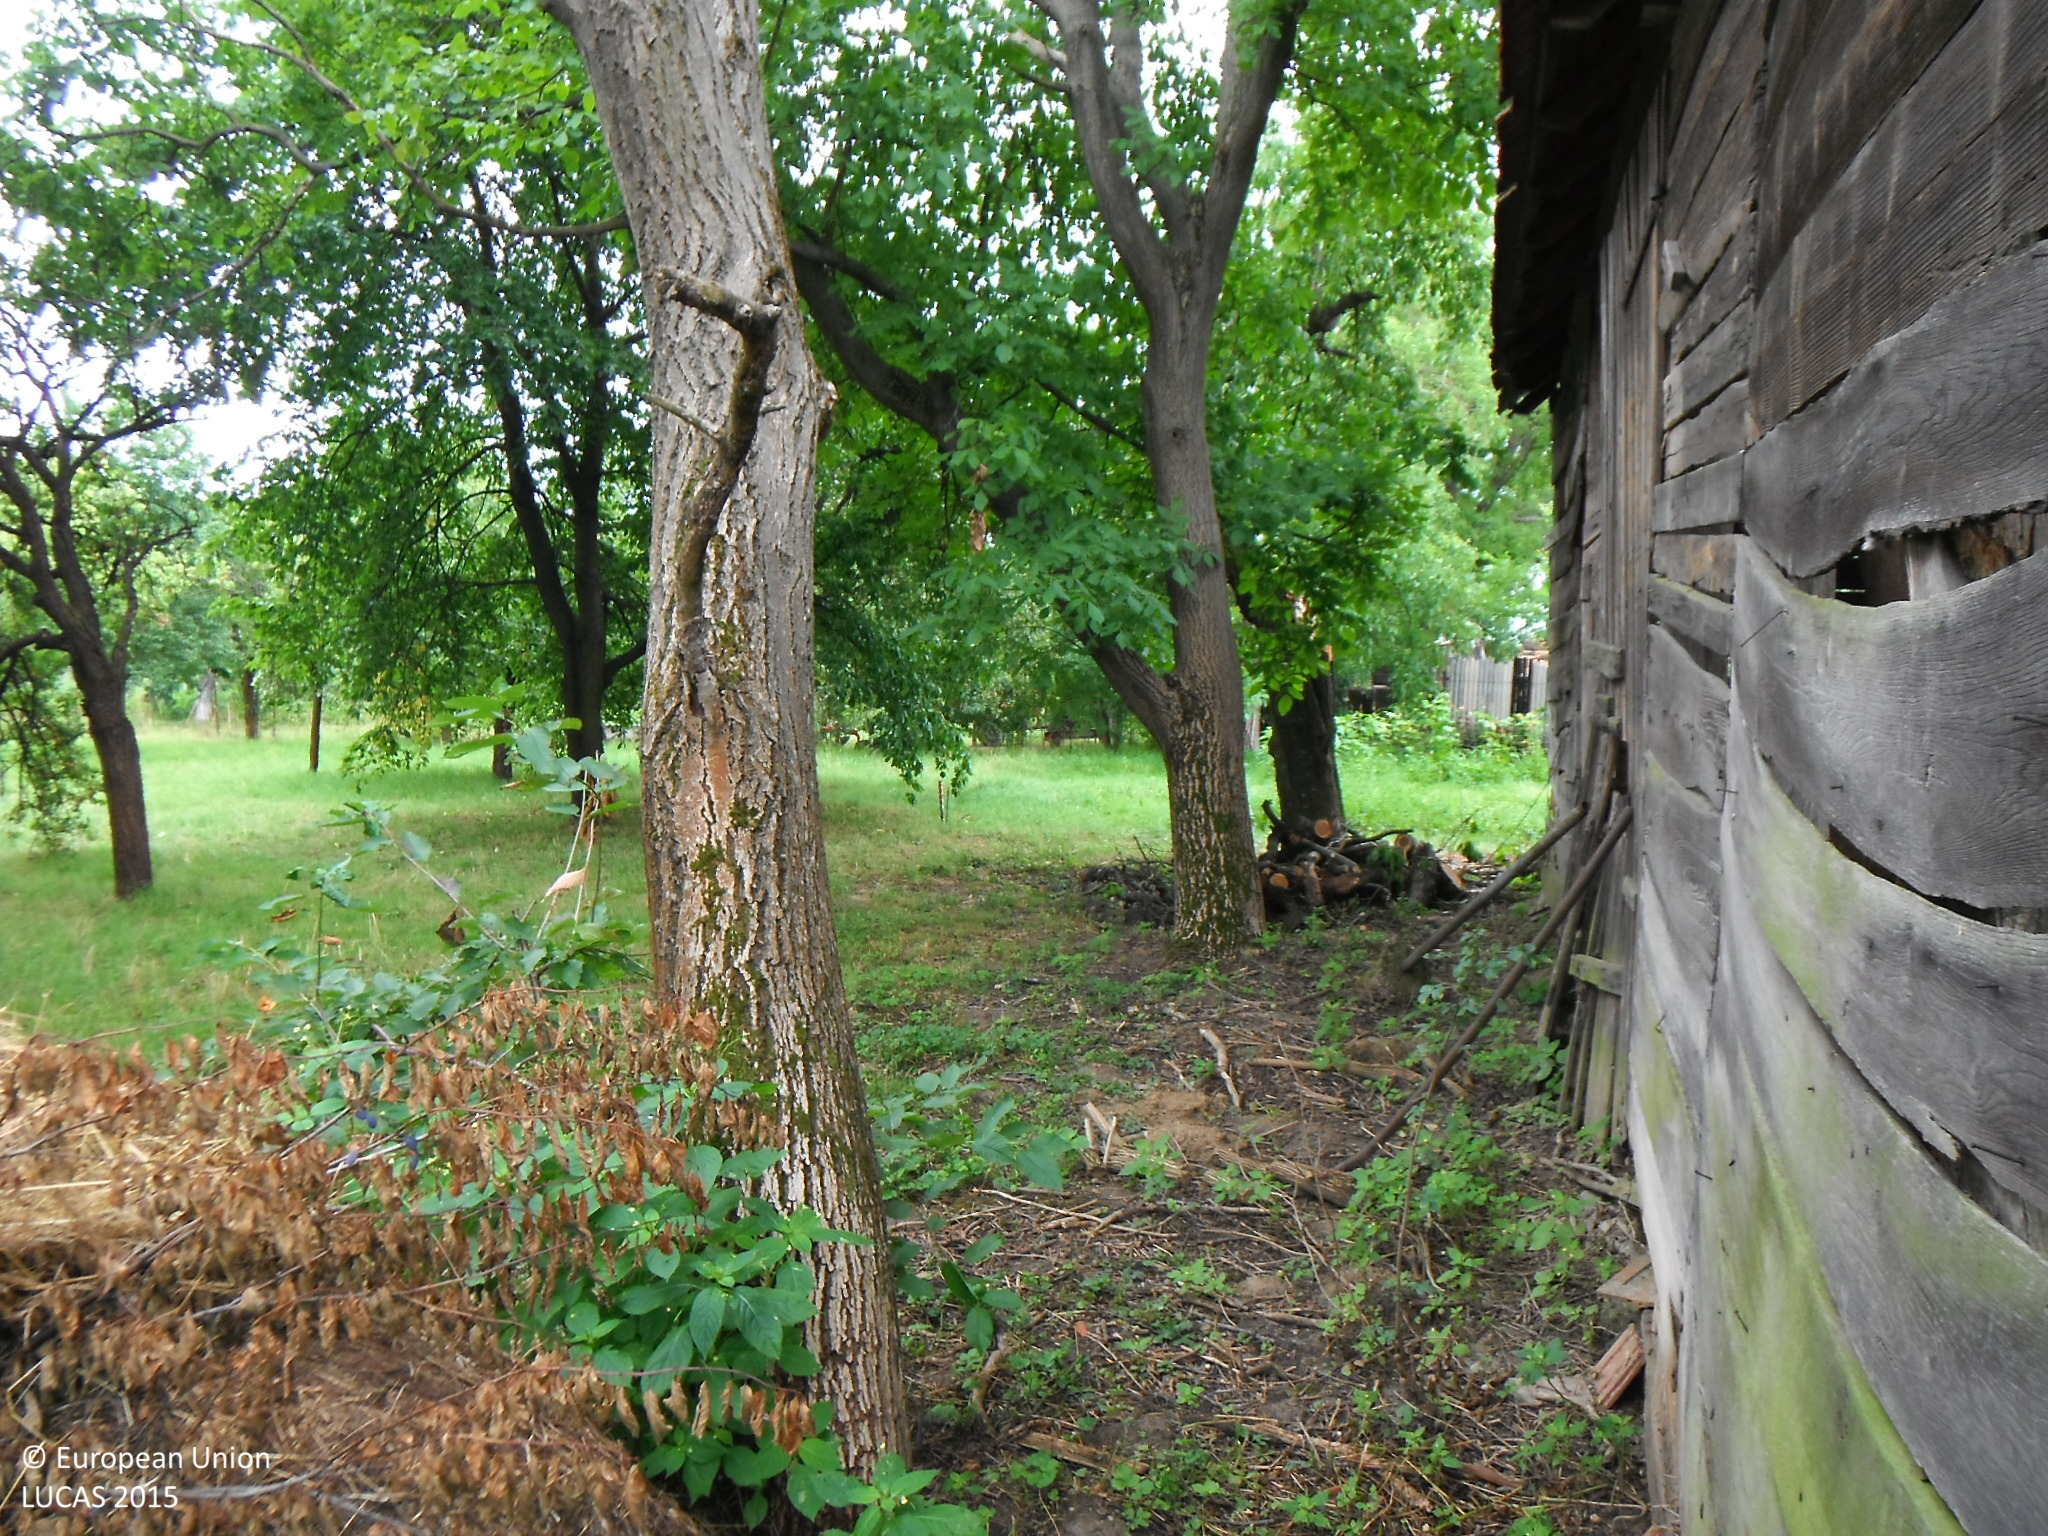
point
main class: Cropland
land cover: Nuts trees
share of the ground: 50 - 75 %
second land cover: Grassland without tree/shrub cover
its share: > 75 %
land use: Kitchen garden
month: July
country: SK
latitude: 48.7821
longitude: 21.3278
